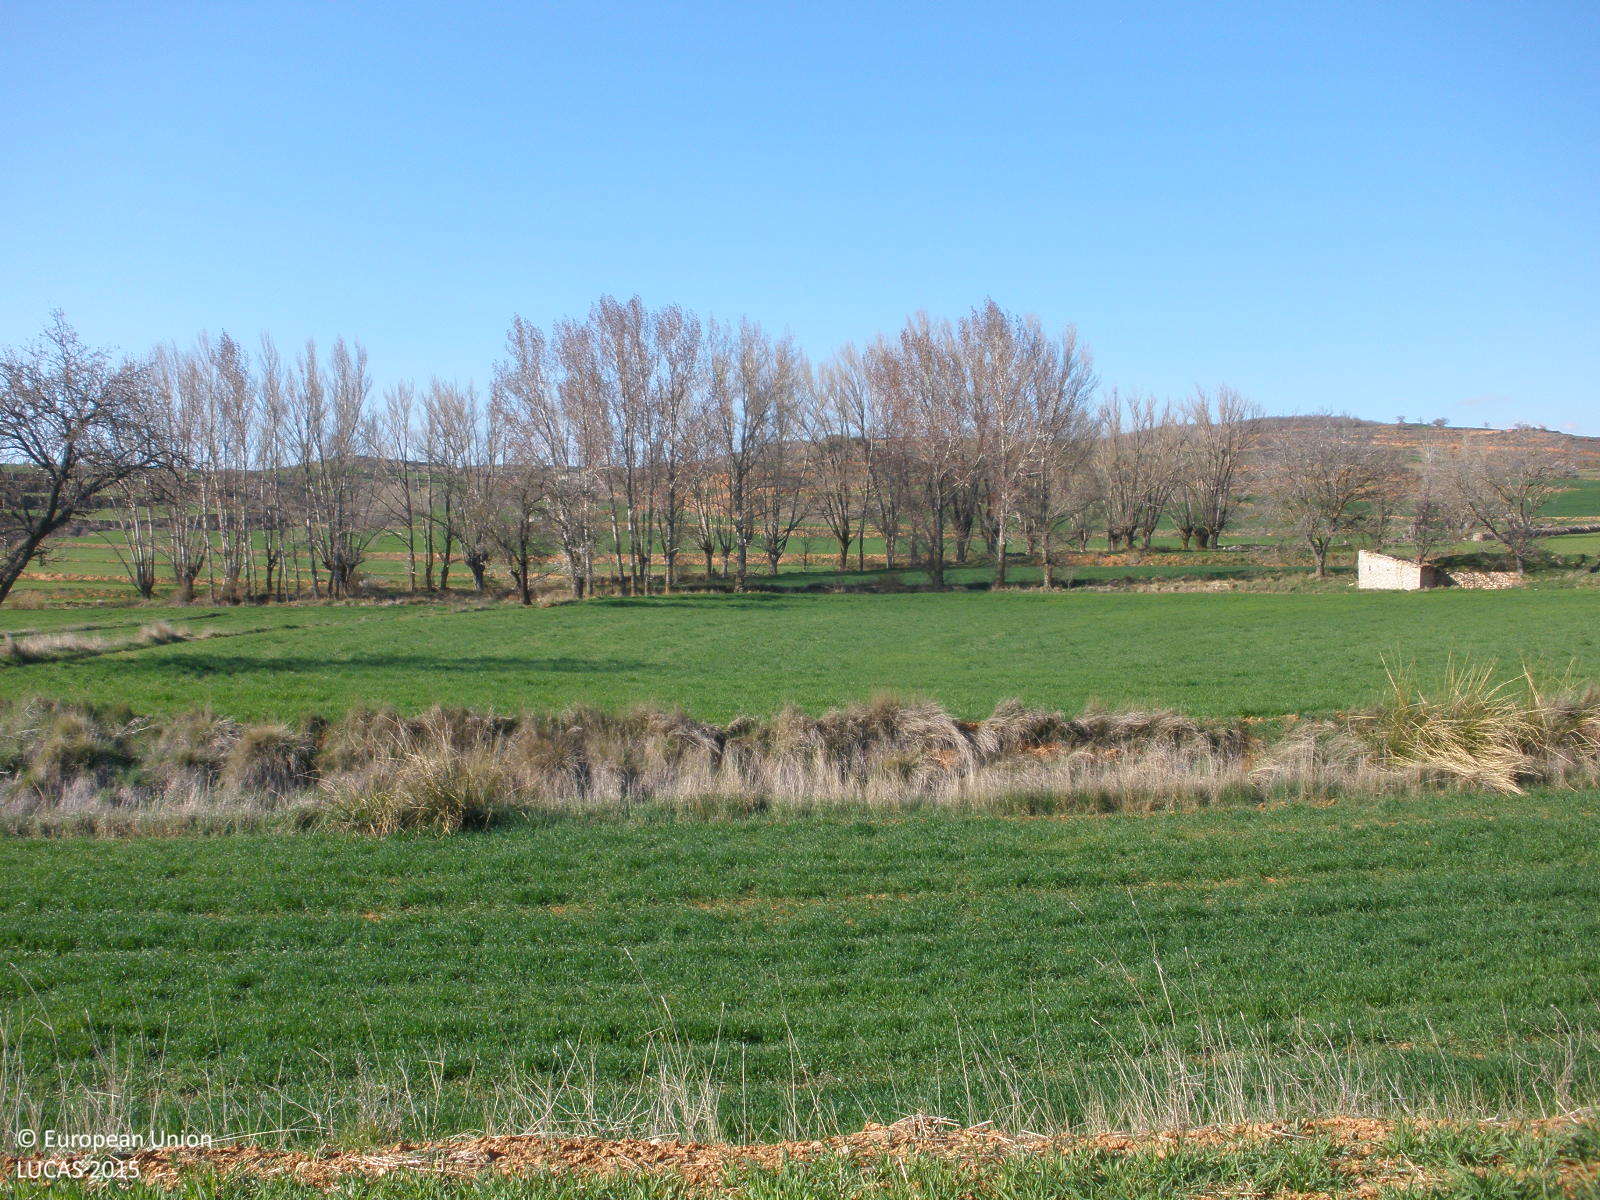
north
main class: Cropland
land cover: Barley
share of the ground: > 75 %
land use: Agriculture (excluding fallow land and kitchen gardens)
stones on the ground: < 10 %
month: April
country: ES
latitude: 40.9103
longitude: -1.1172
